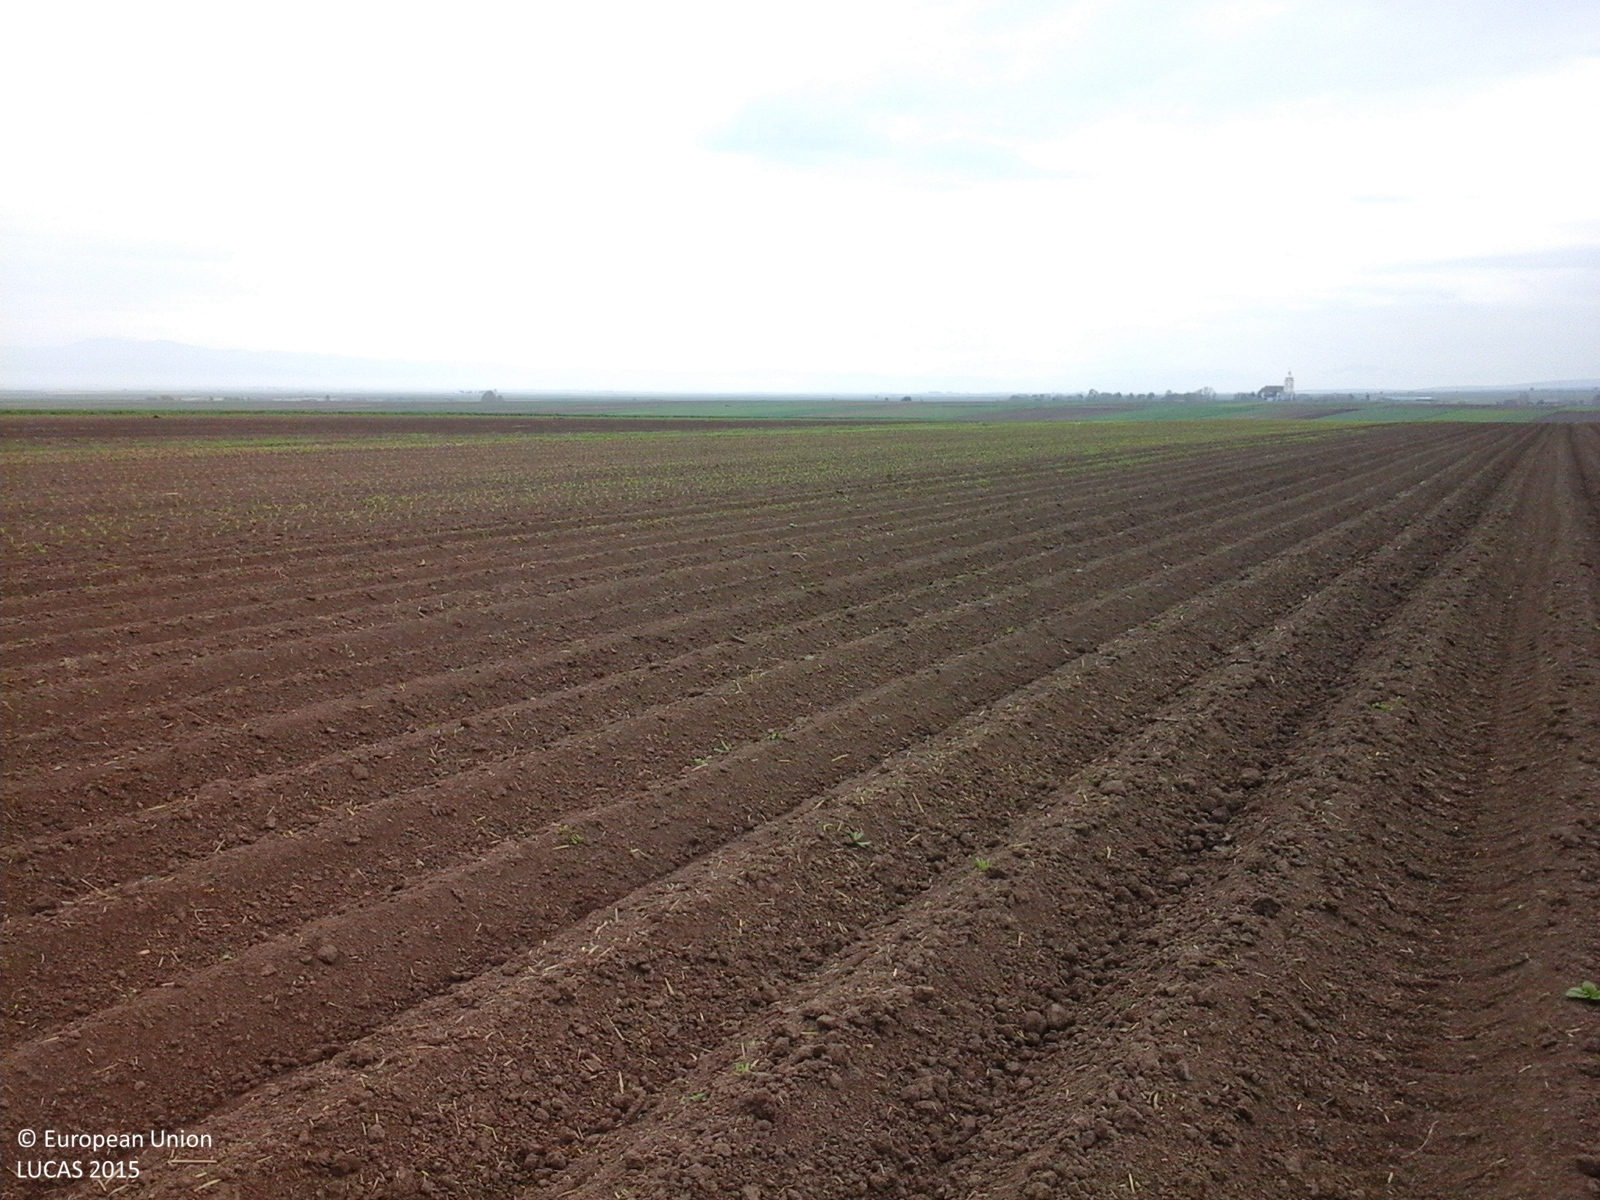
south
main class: Cropland
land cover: Potatoes
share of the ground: < 10 %
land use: Agriculture (excluding fallow land and kitchen gardens)
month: May
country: RO
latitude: 46.0423
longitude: 26.0784
